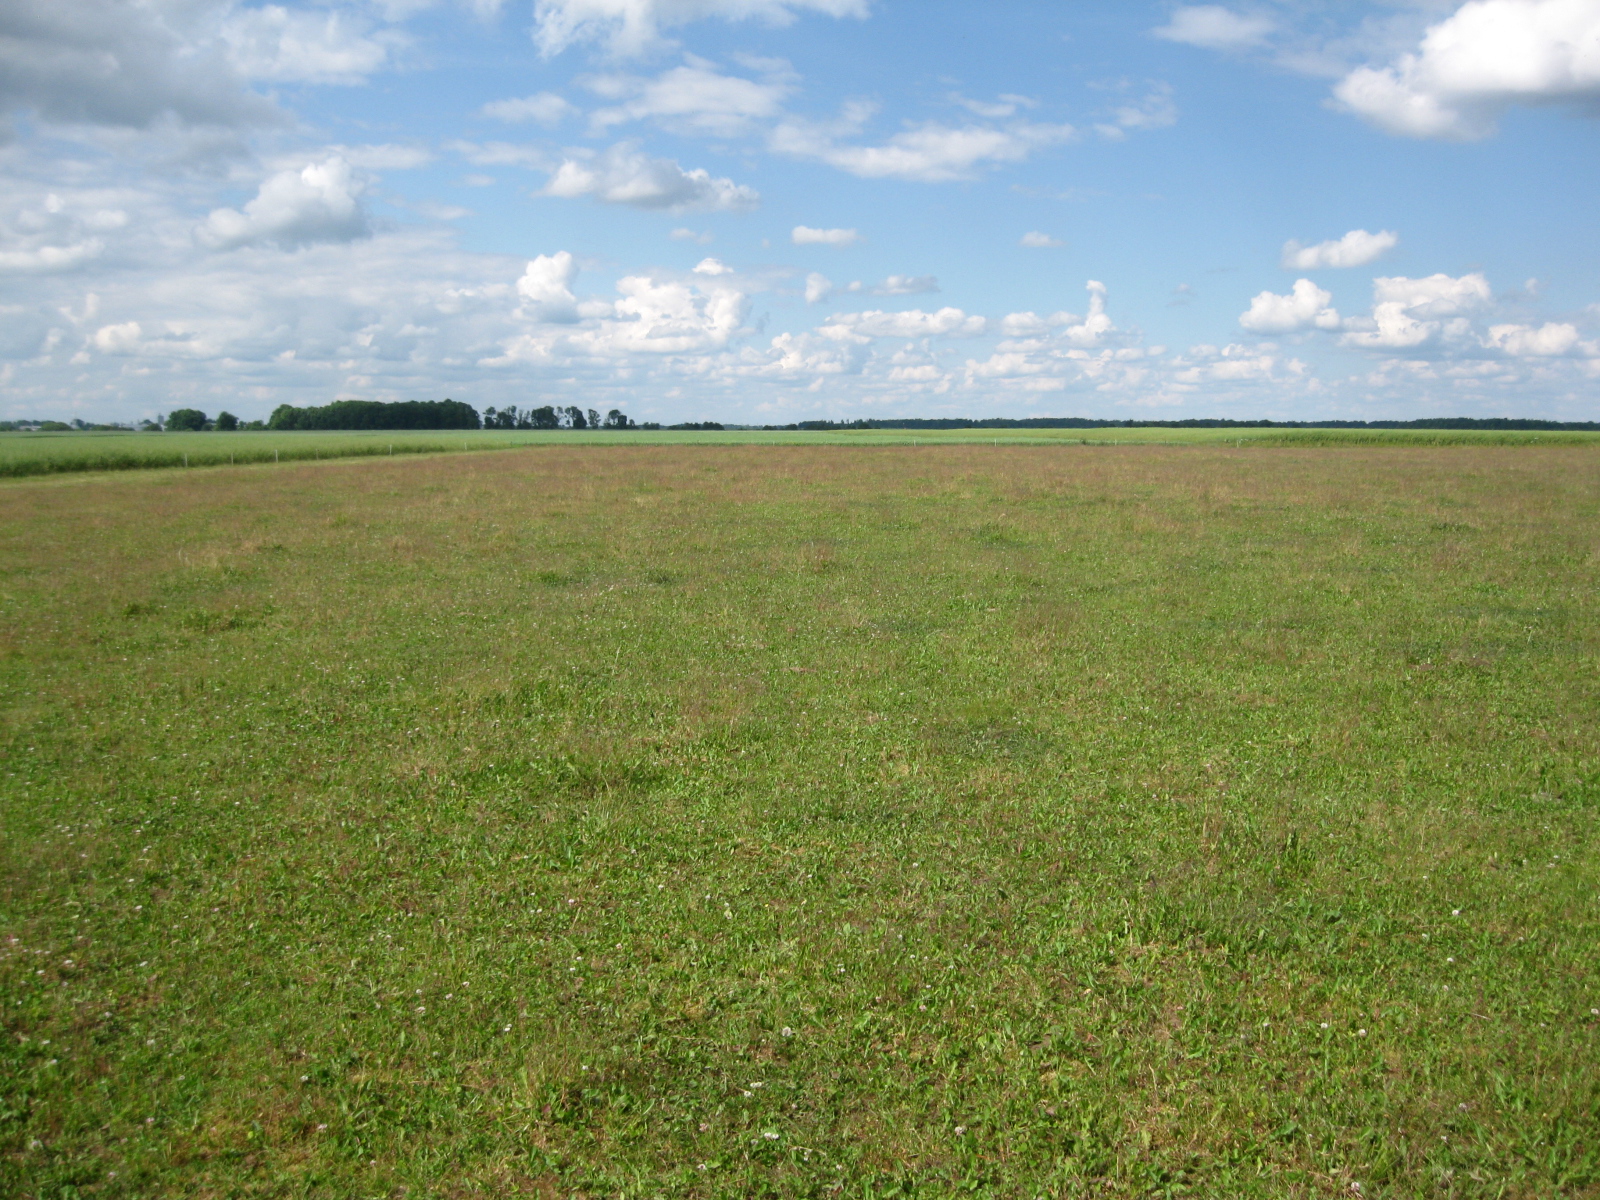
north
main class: Grassland
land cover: Grassland without tree/shrub cover
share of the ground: > 75 %
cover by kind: herbaceous plants 100 %
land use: Agriculture (excluding fallow land and kitchen gardens)
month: June
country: LT
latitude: 55.3194
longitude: 24.0369
